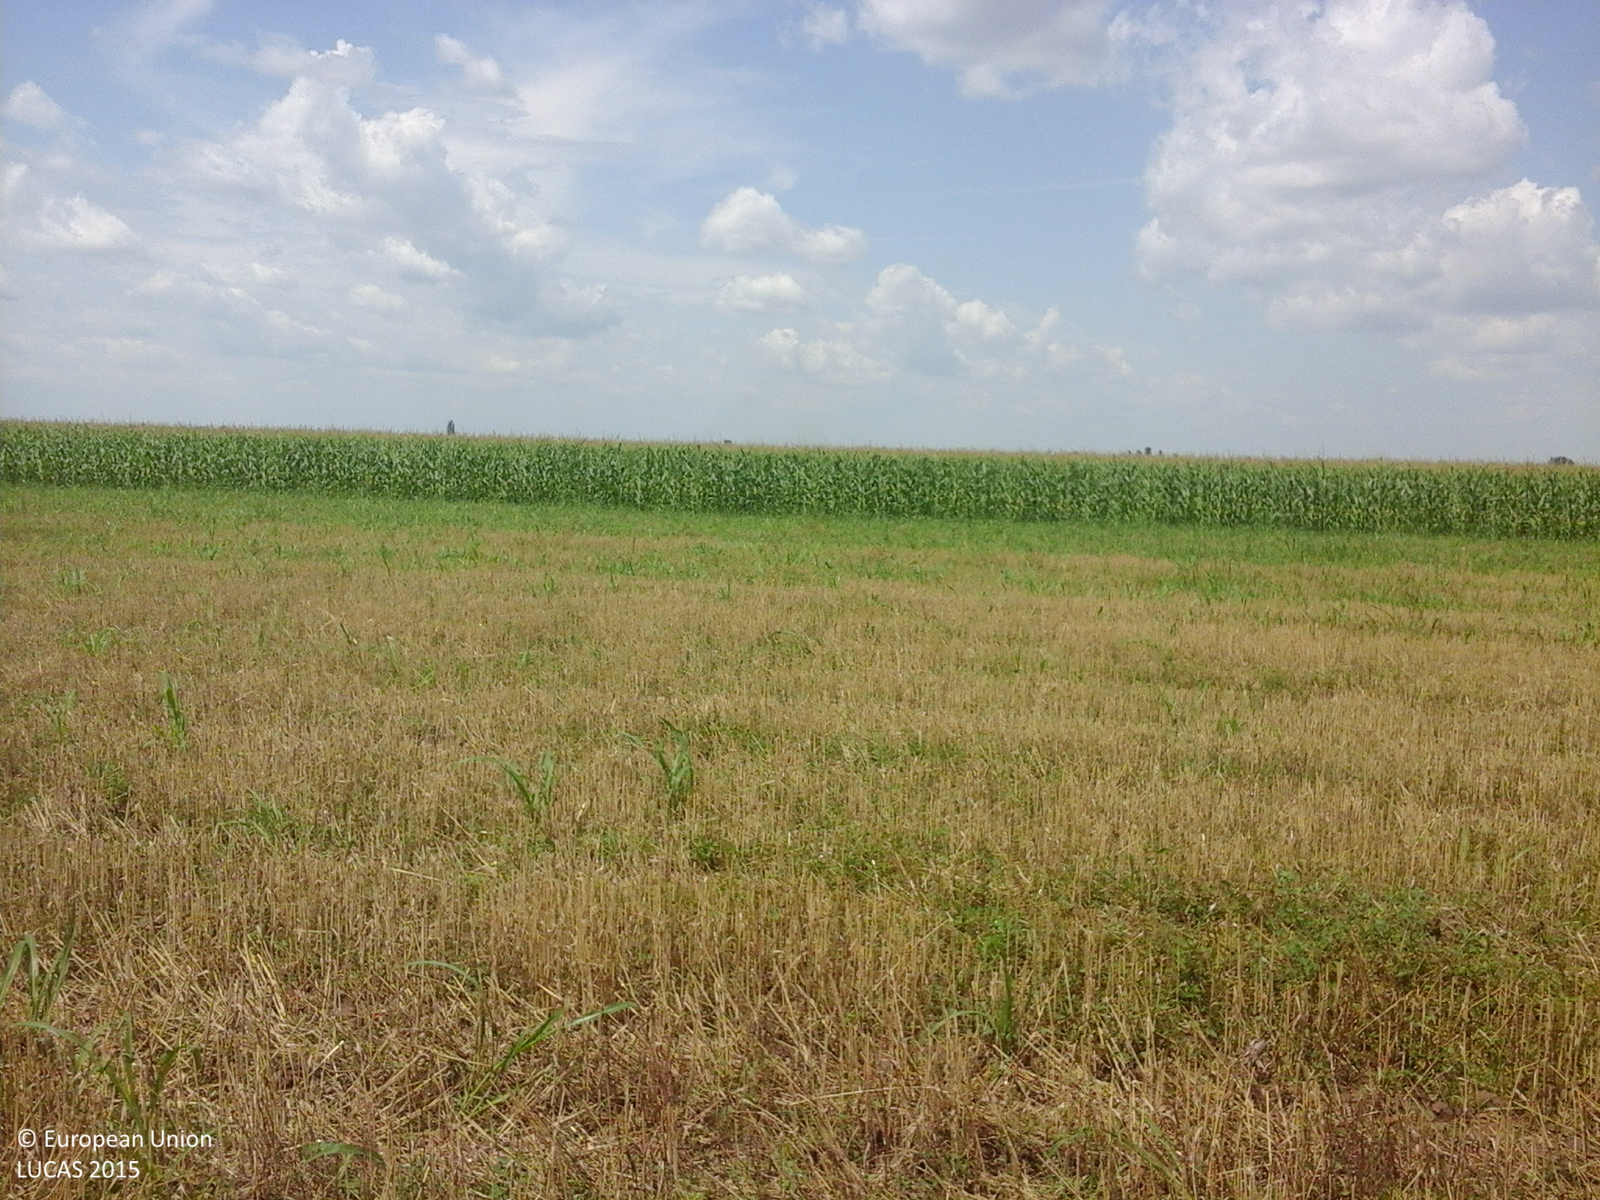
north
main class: Cropland
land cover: Maize
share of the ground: > 75 %
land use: Agriculture (excluding fallow land and kitchen gardens)
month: July
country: RO
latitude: 43.8480
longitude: 24.4310
